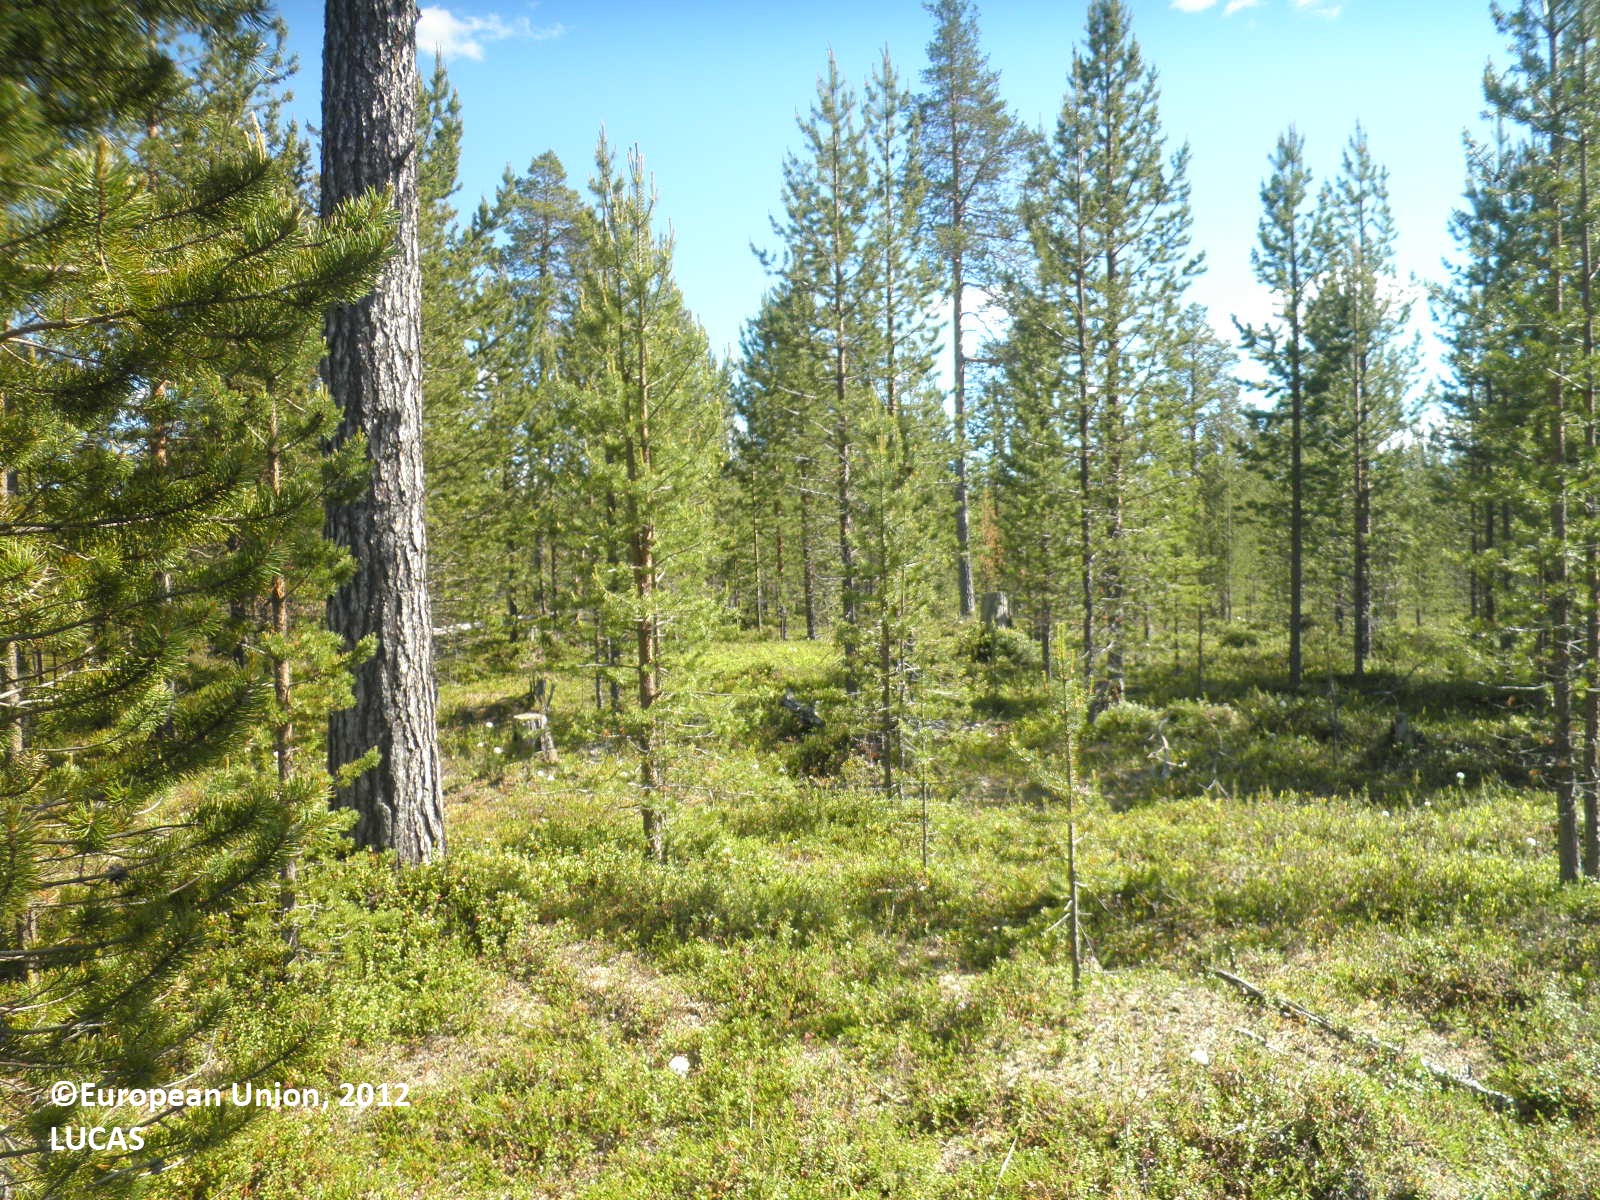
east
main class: Woodland
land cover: Pine dominated coniferous woodland
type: boreal forest
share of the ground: 25 - 50 %
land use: Forestry
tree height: > 5 m
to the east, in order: Pine dominated coniferous woodland
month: July
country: FI
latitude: 68.7972
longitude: 26.8302
